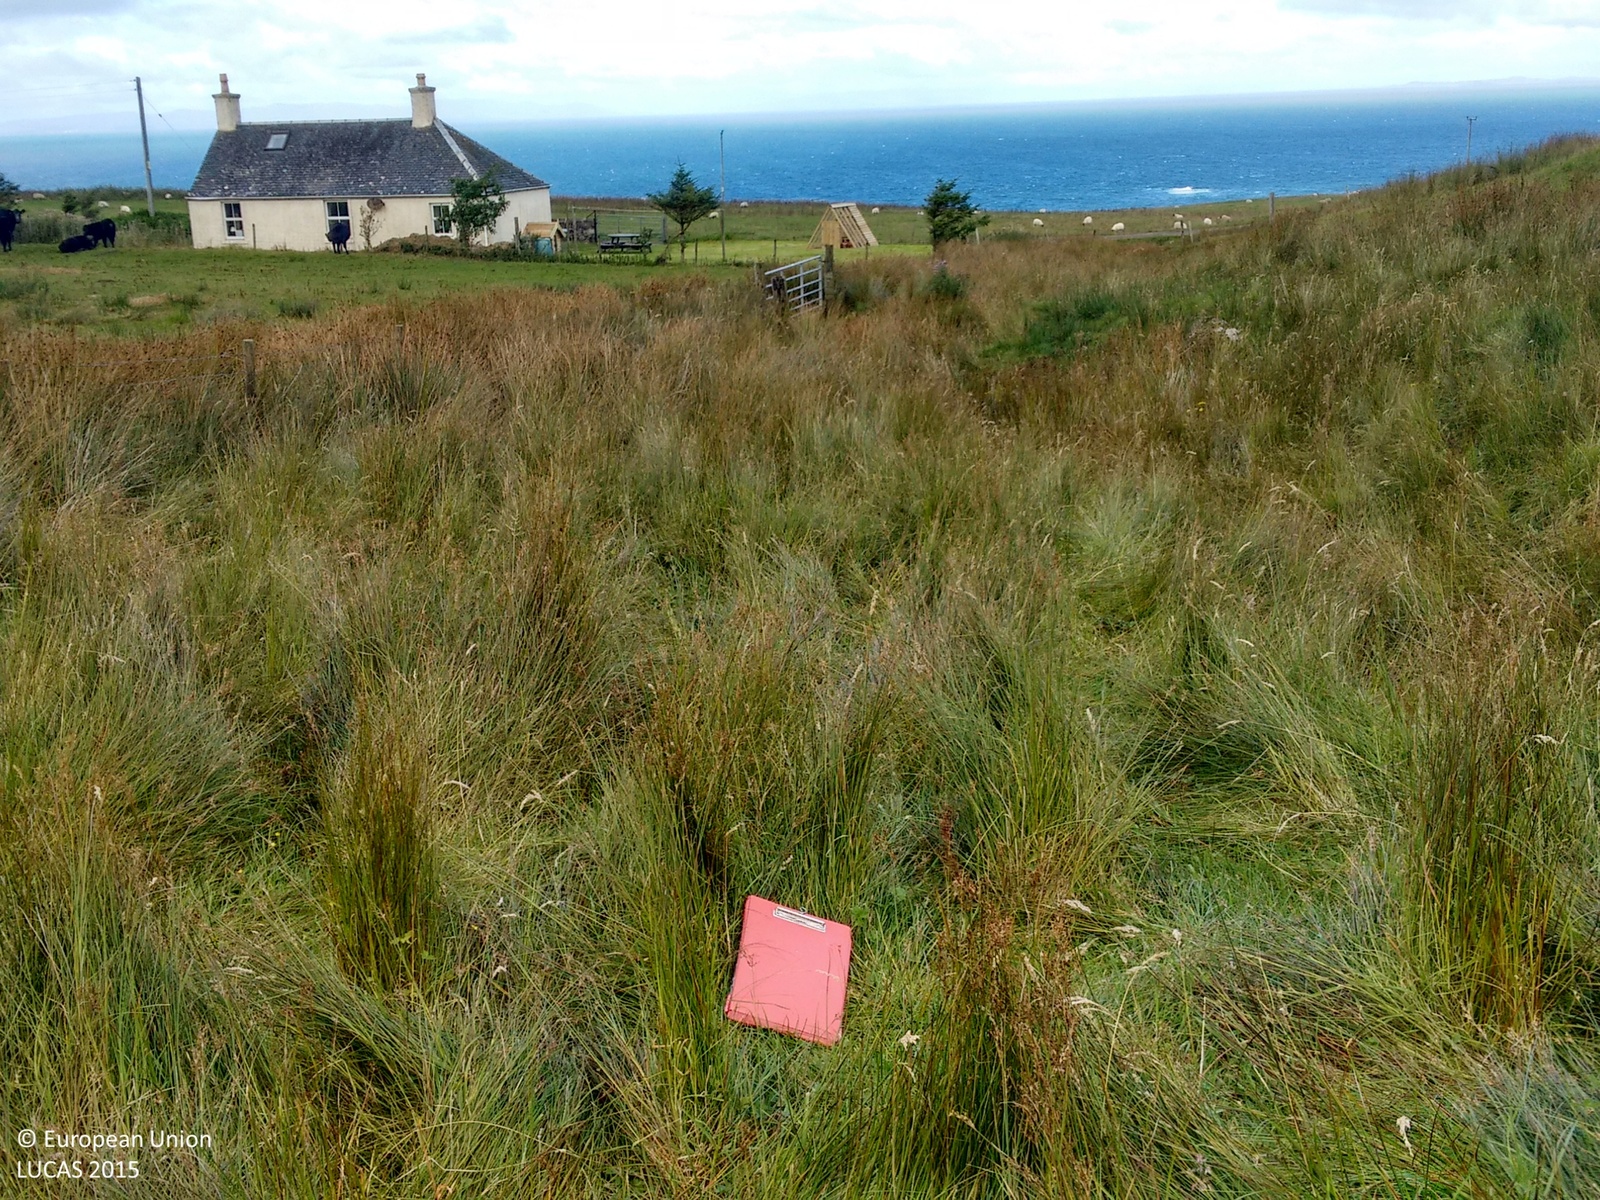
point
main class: Grassland
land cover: Grassland without tree/shrub cover
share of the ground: > 75 %
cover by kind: herbaceous plants 100 %
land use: Agriculture (excluding fallow land and kitchen gardens)
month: September
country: GB
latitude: 55.4077
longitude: -5.7514
